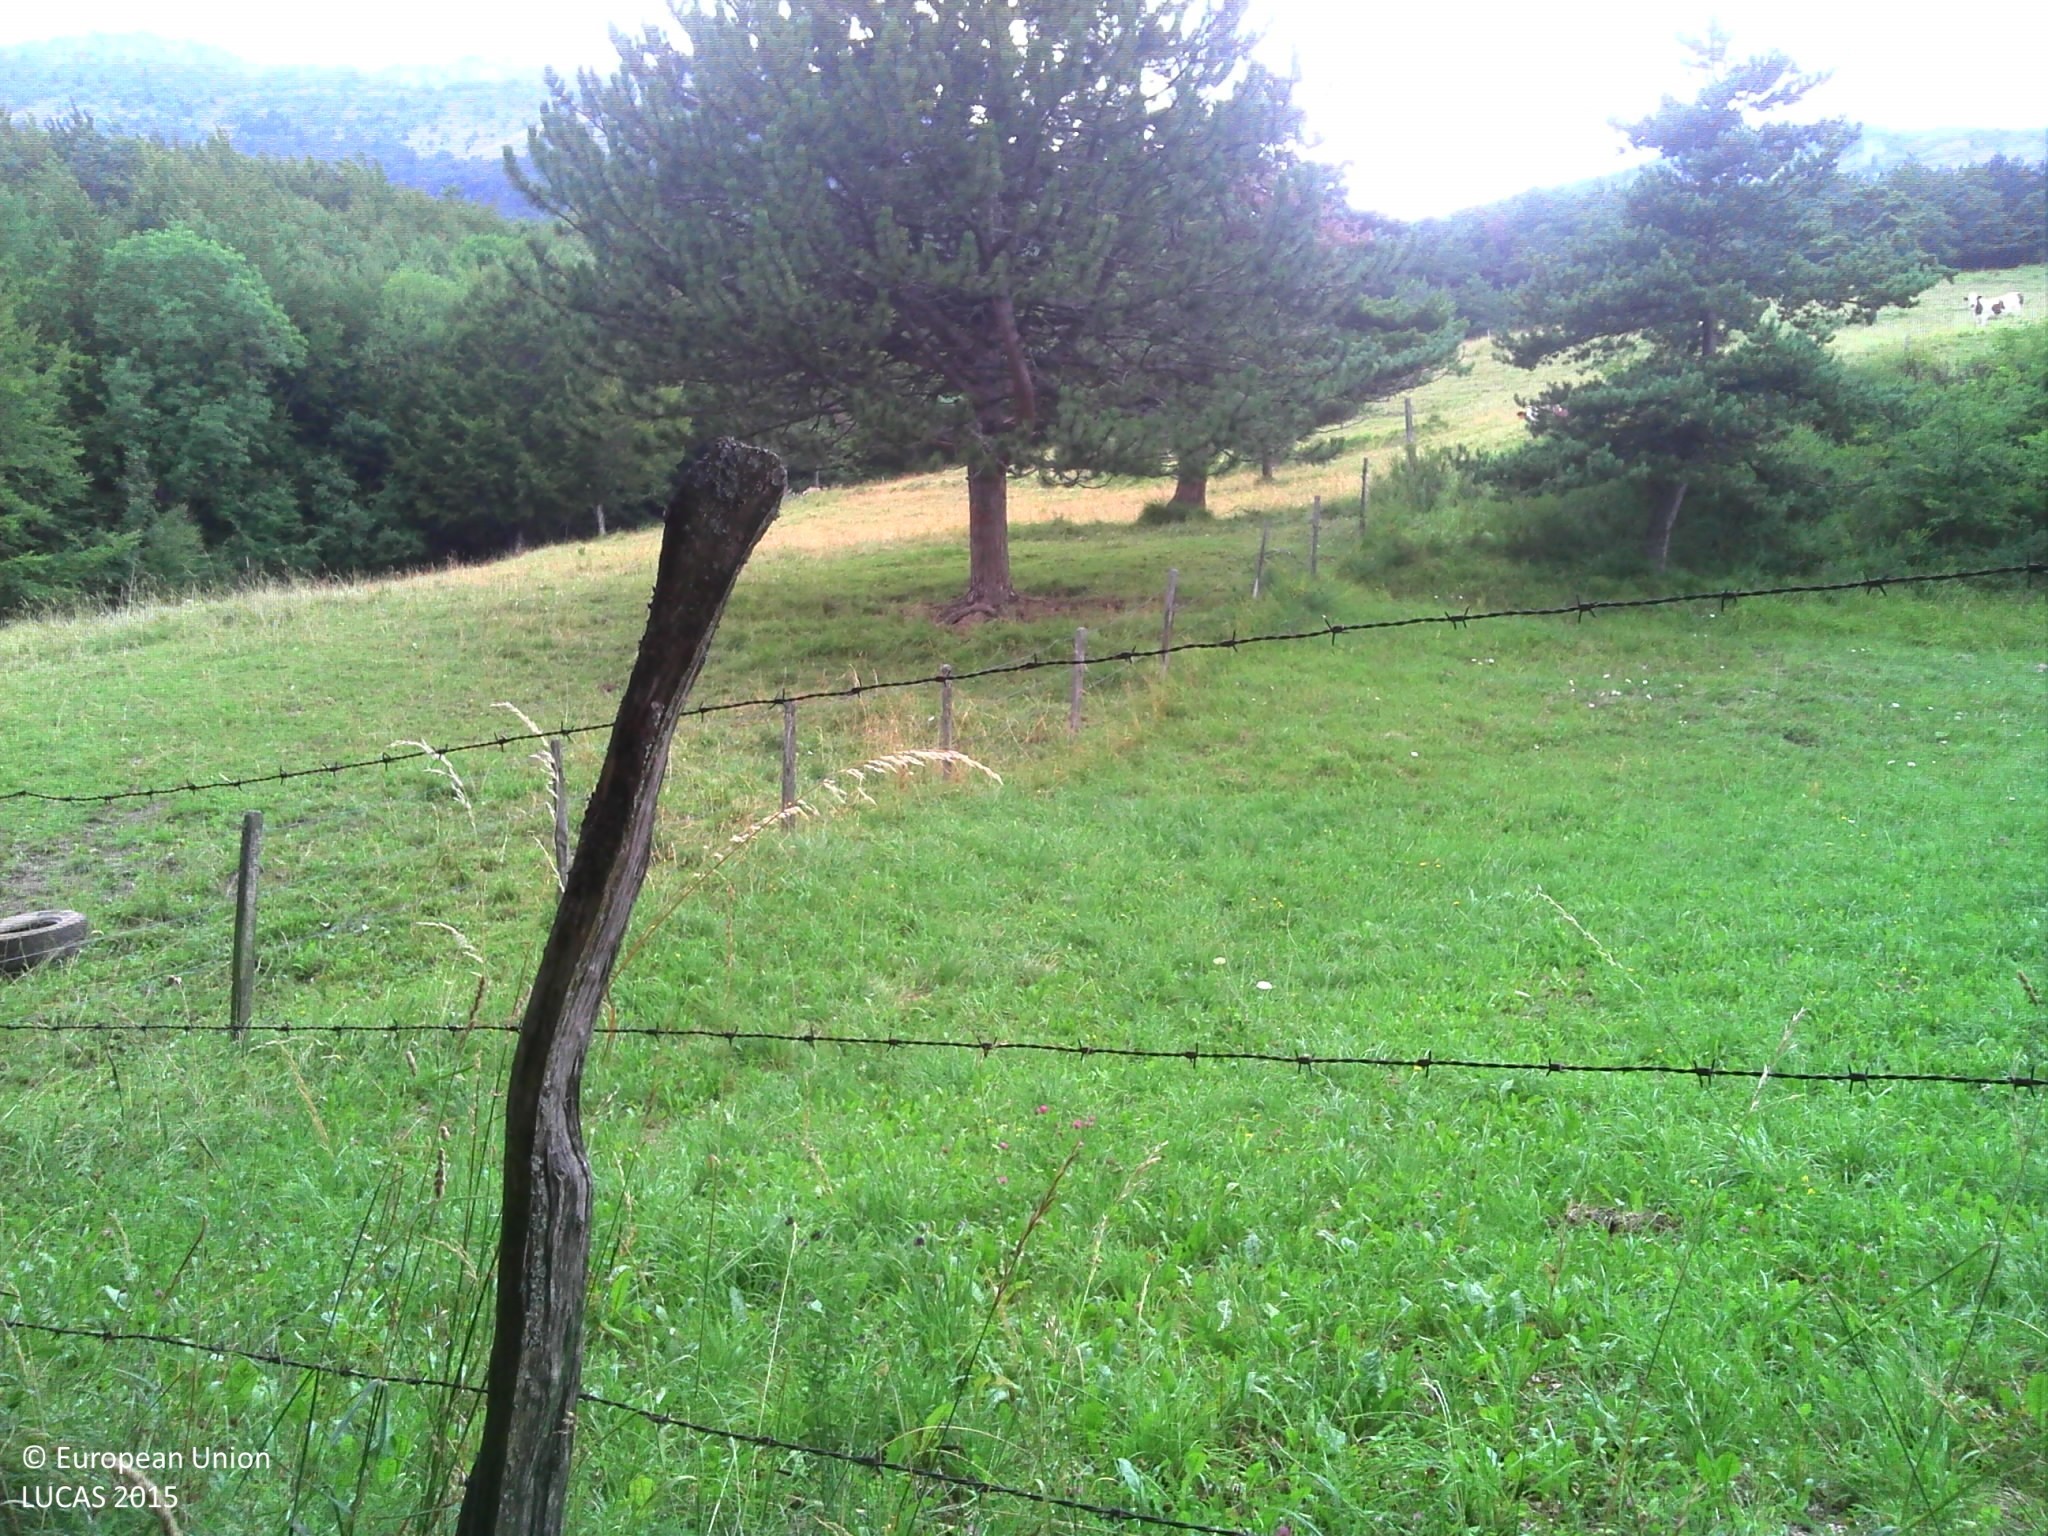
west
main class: Grassland
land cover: Grassland without tree/shrub cover
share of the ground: > 75 %
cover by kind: herbaceous plants 100 %
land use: Agriculture (excluding fallow land and kitchen gardens)
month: July
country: FR
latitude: 44.9078
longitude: 5.6110
